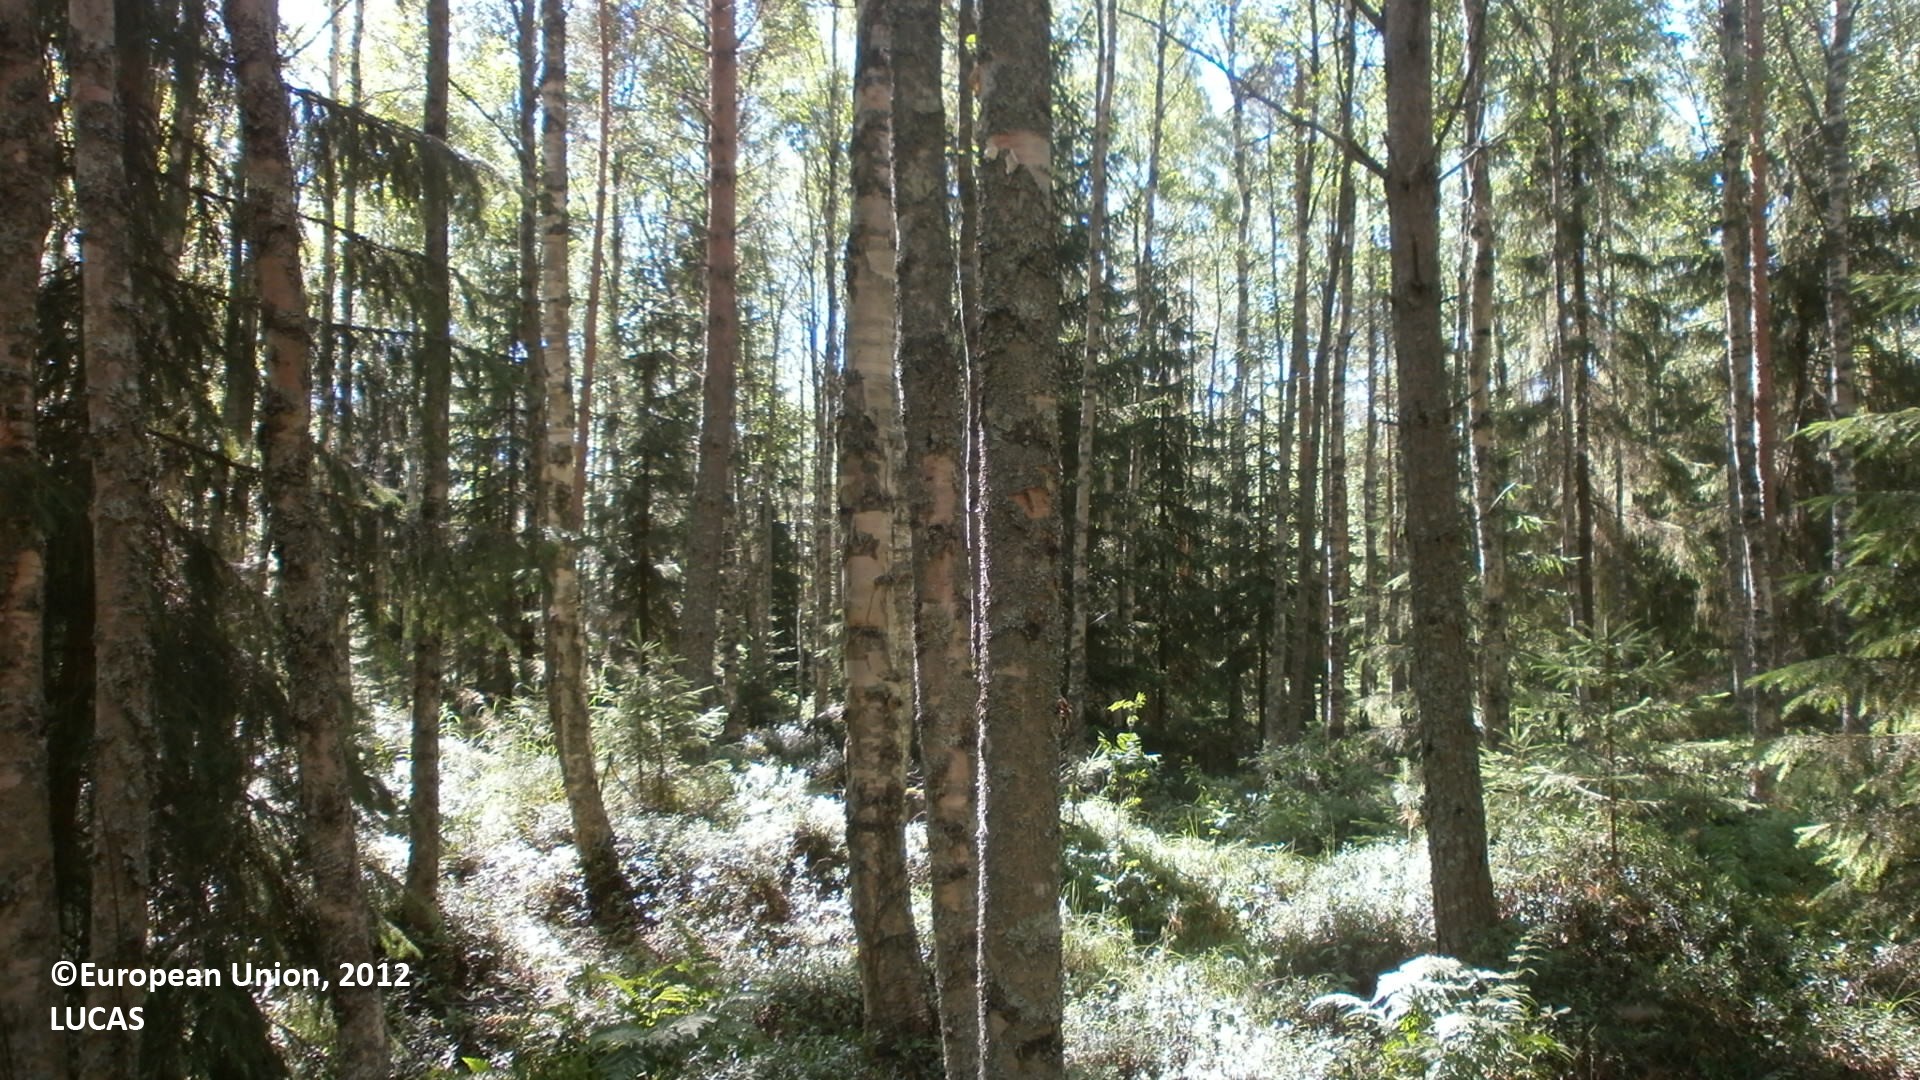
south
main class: Woodland
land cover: Broadleaved woodland
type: boreal forest
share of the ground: > 75 %
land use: Forestry
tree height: > 5 m
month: July
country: FI
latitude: 64.2810
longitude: 24.0877
